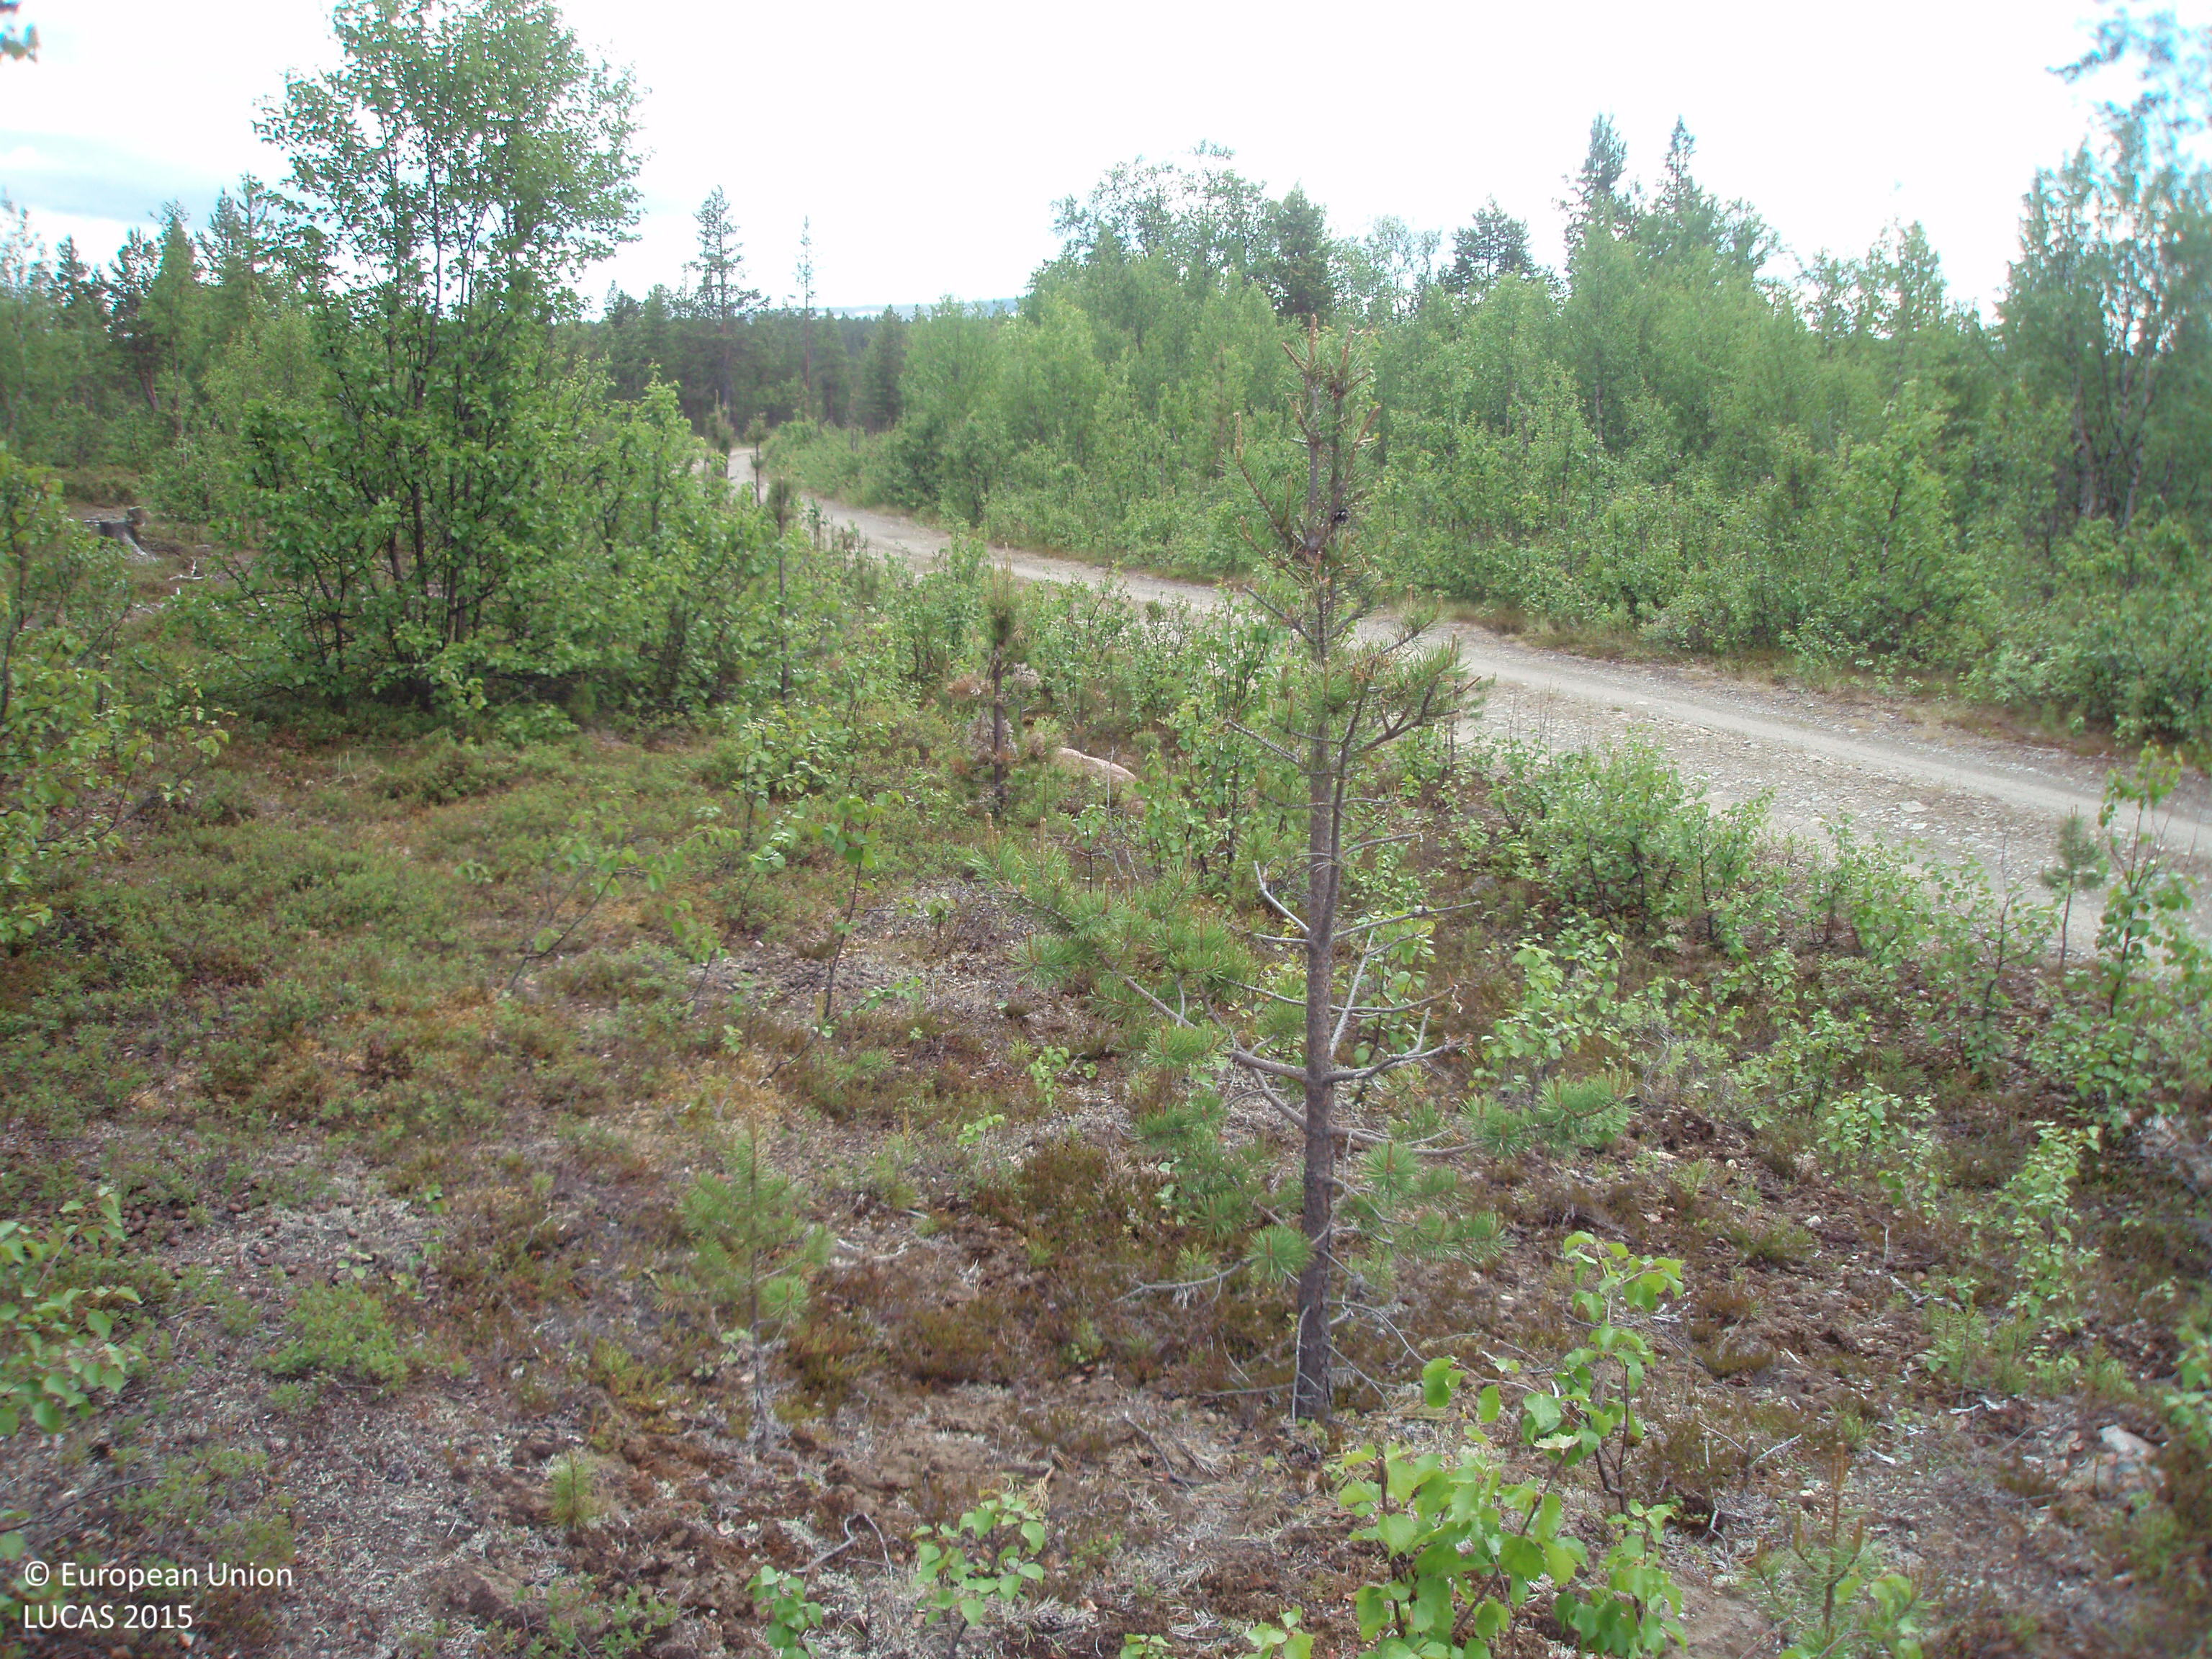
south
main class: Woodland
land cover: Pine dominated mixed woodland
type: boreal forest
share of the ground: 50 - 75 %
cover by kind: coniferous forest trees 30 %, shrubs 30 %, broadleaved forest trees 20 %, unconsolidated bare surface 20 %
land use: Forestry
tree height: > 5 m
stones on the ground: < 10 %
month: July
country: FI
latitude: 68.8732
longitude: 25.7690
